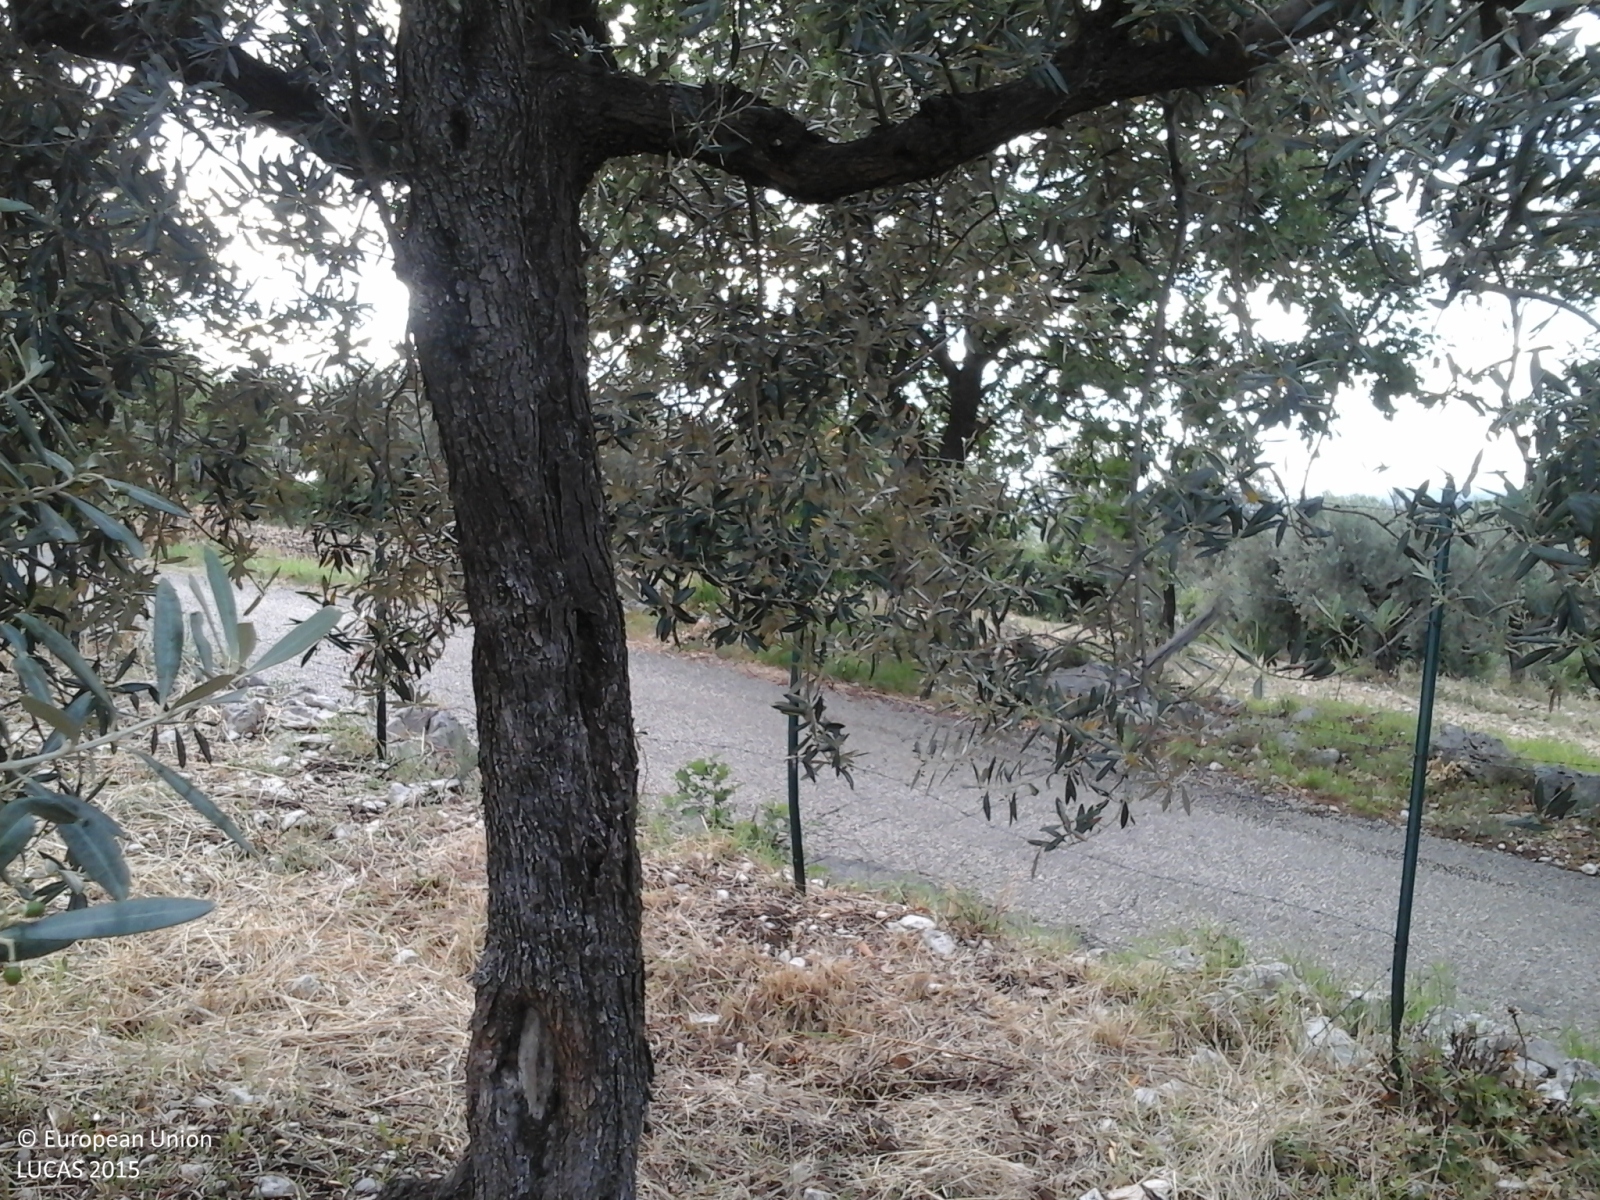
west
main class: Cropland
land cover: Olive groves
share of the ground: 50 - 75 %
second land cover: Grassland without tree/shrub cover
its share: > 75 %
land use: Agriculture (excluding fallow land and kitchen gardens)
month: June
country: IT
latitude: 42.1277
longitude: 12.7846
